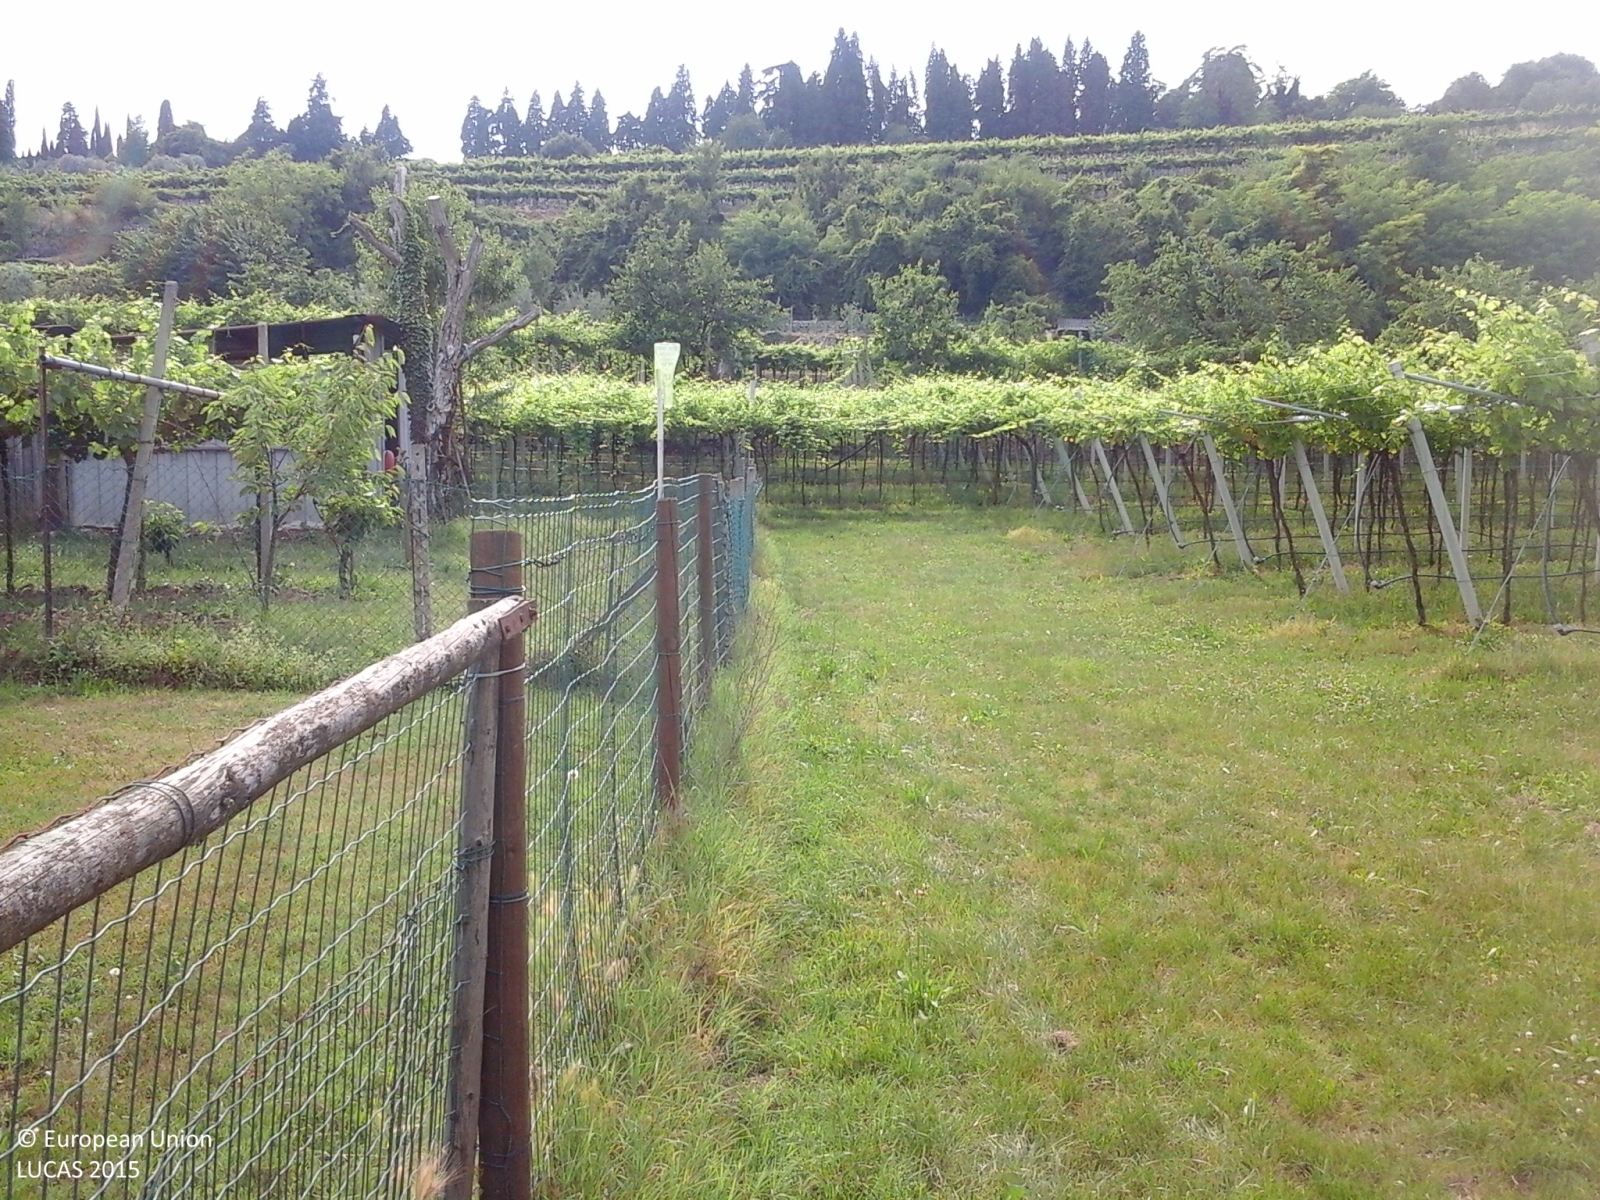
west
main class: Cropland
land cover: Potatoes
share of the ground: > 75 %
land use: Agriculture (excluding fallow land and kitchen gardens)
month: June
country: IT
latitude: 45.5005
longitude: 10.9071
